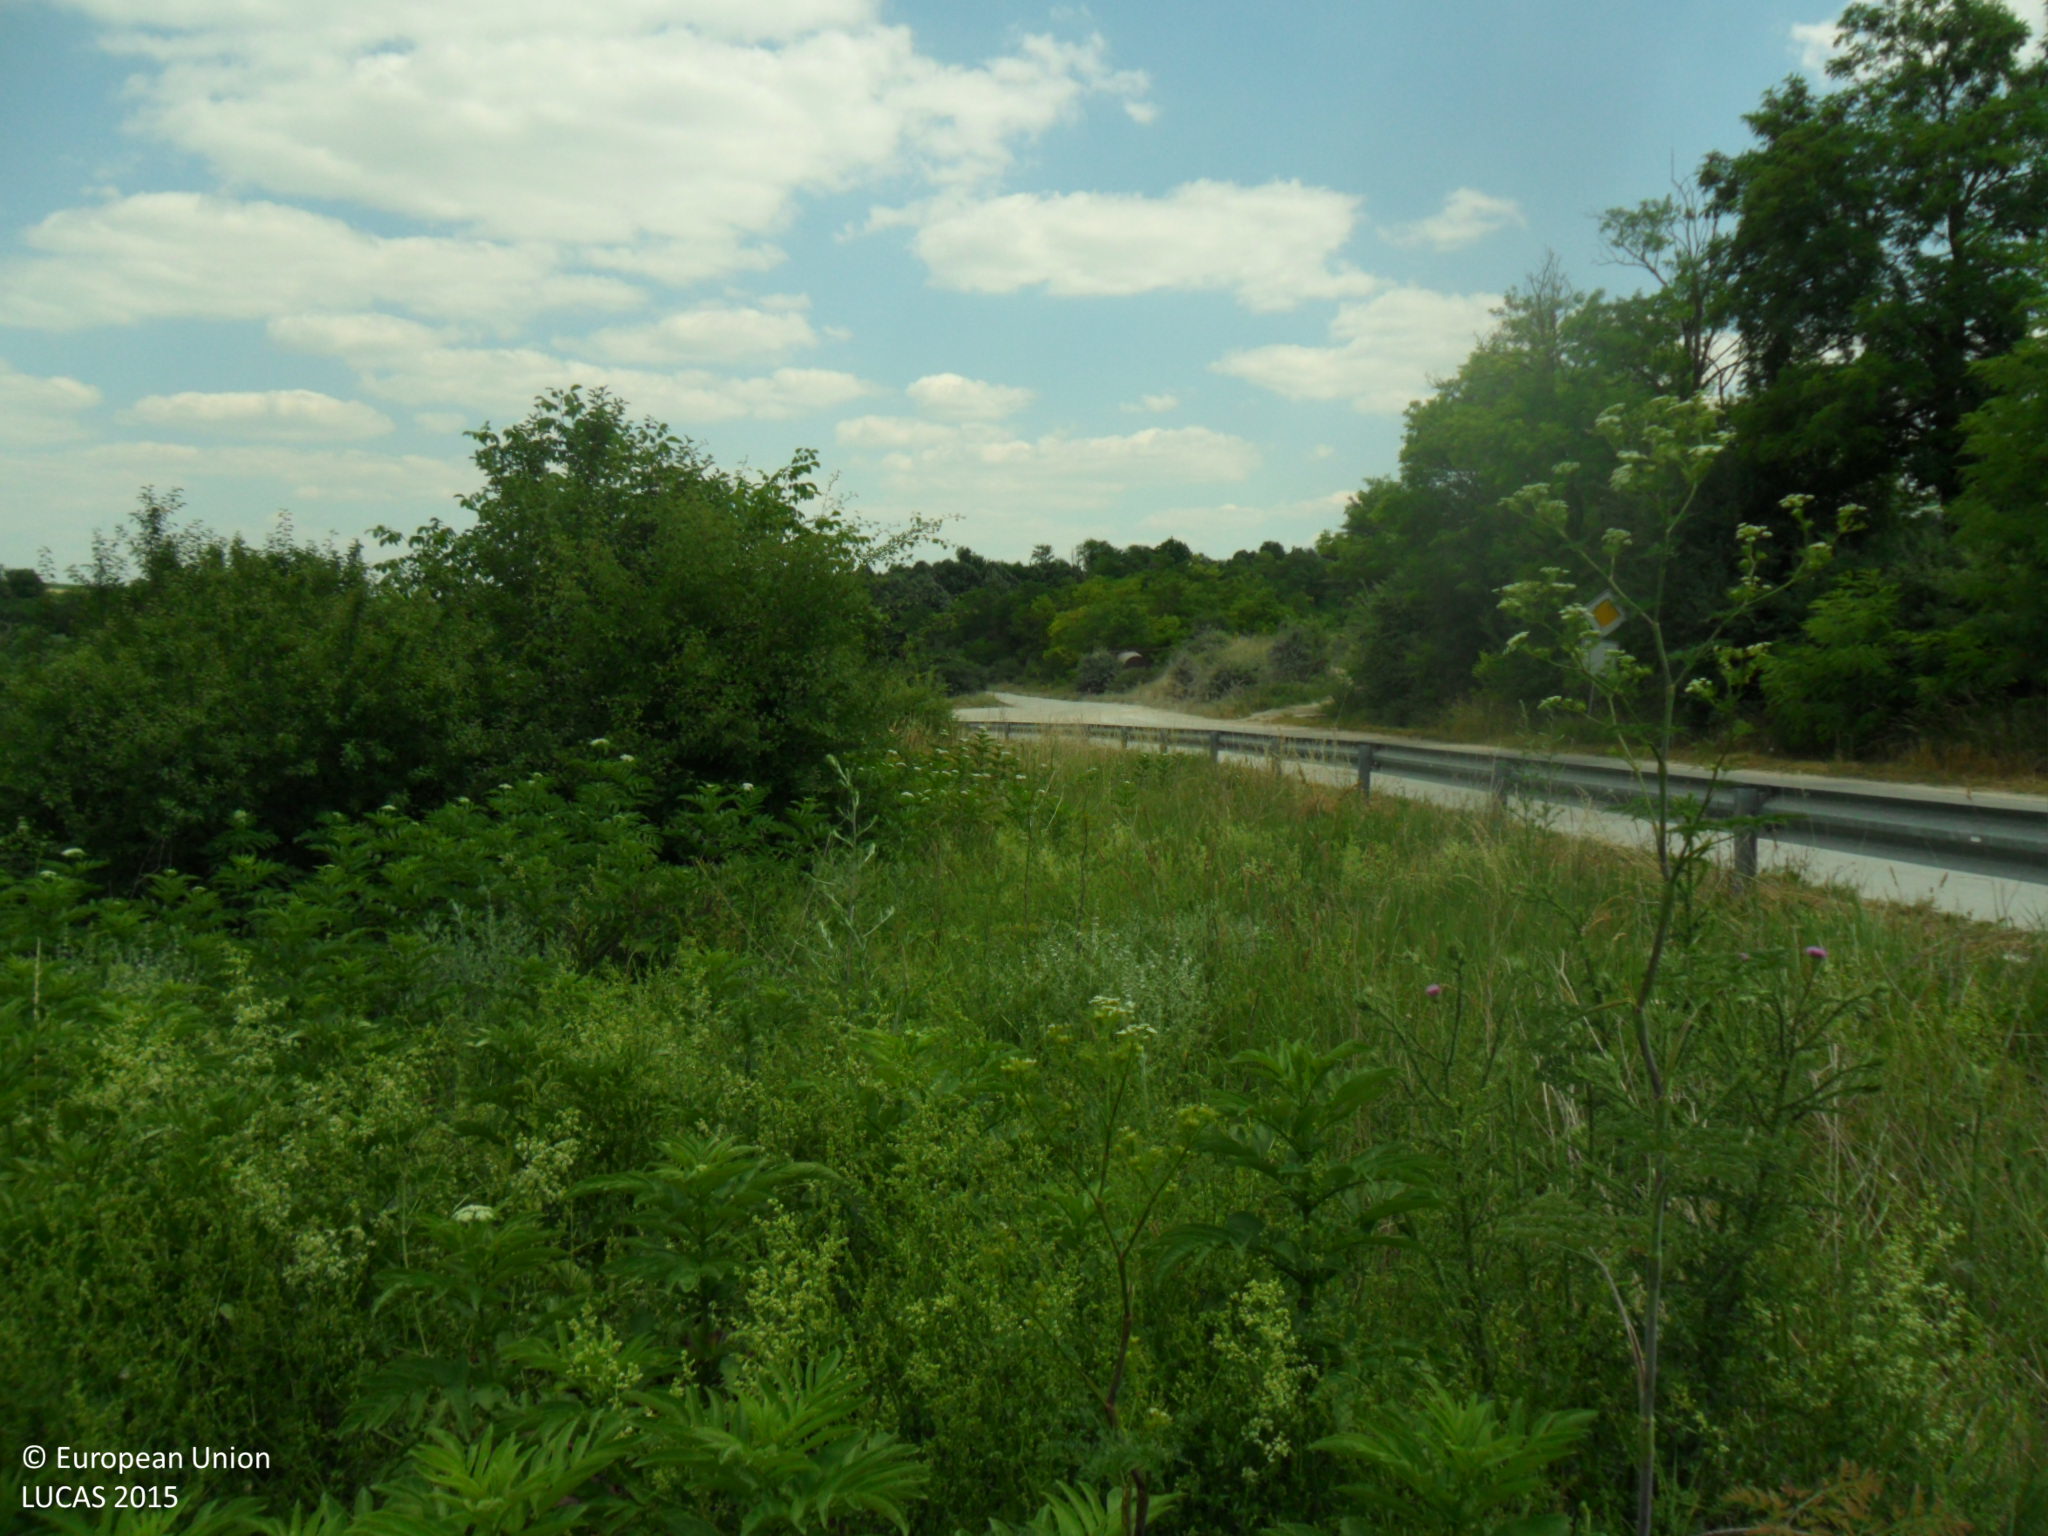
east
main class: Shrubland
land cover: Shrubland with sparse tree cover
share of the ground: > 75 %
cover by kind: shrubs 75 %, herbaceous plants 20 %, broadleaved forest trees 5 %
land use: Abandoned areas
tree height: > 5 m
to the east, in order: Shrubland with sparse tree cover; Rivers and streams; Paved roads, cycling and walking lanes; Grassland with sparse tree/shrub cover
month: June
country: BG
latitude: 43.4261
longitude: 26.9262
